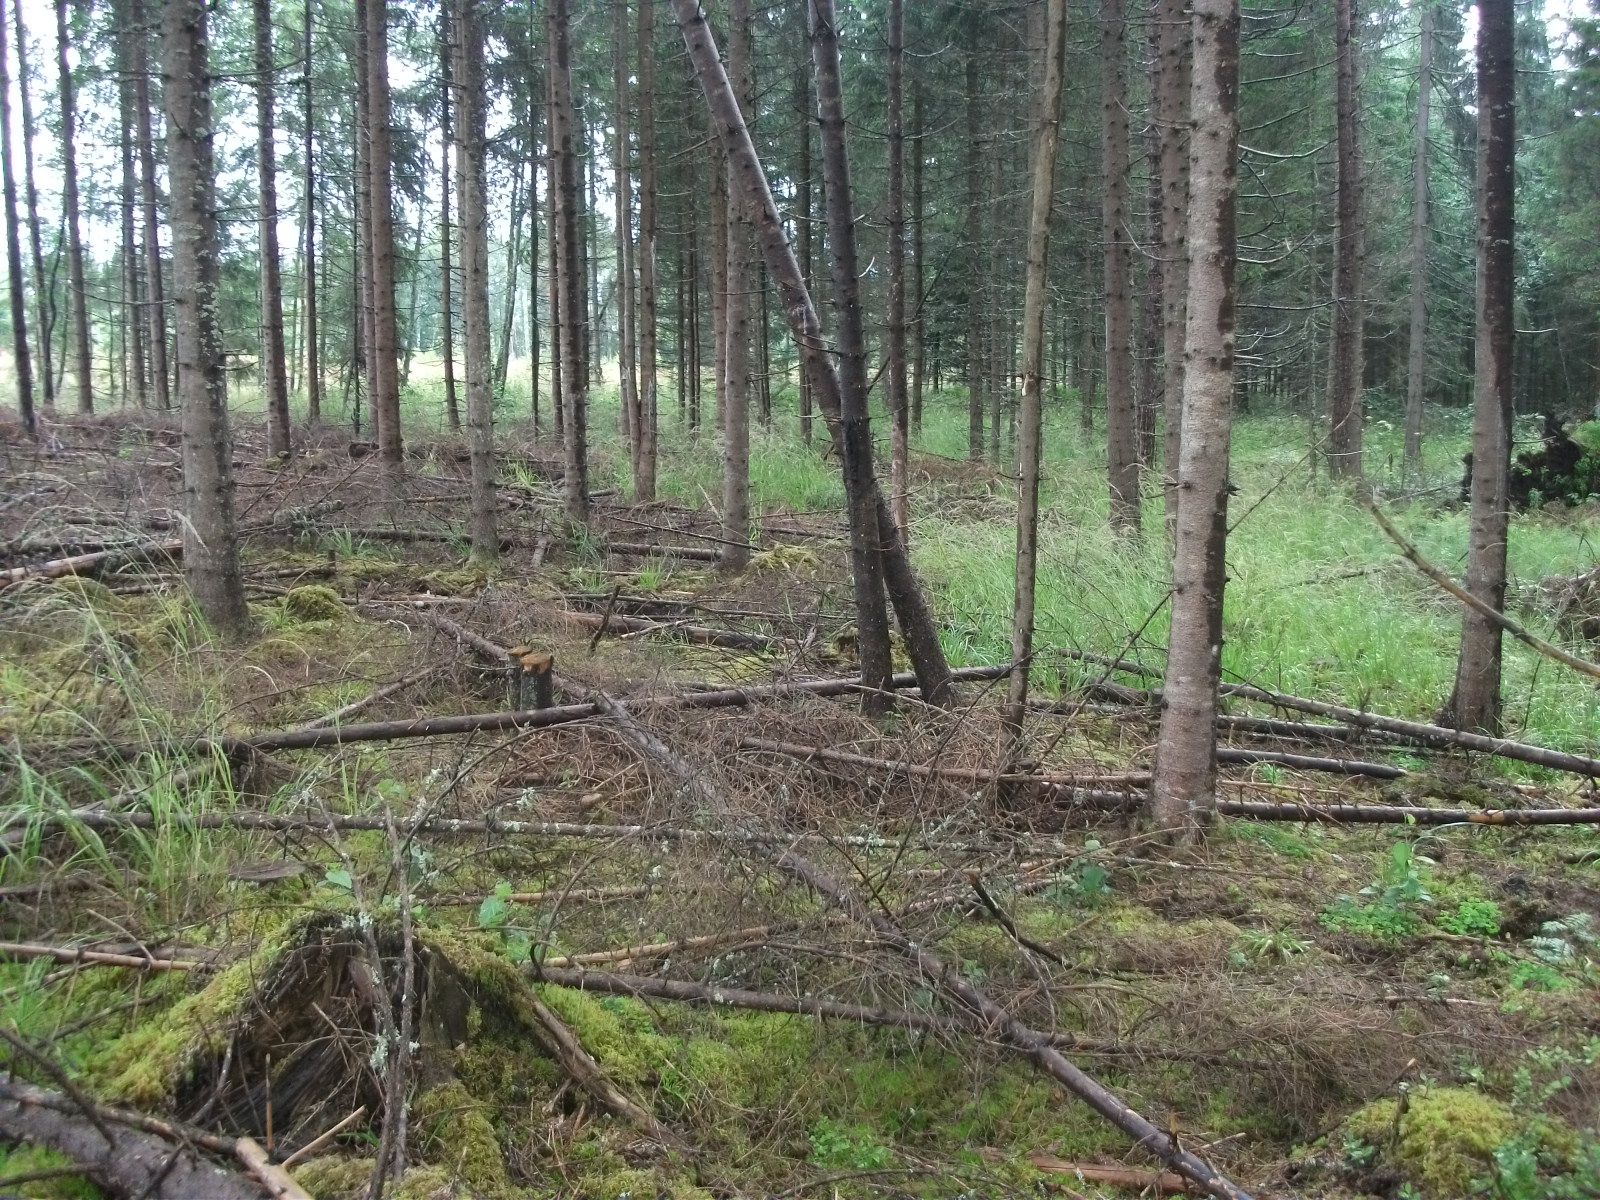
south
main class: Woodland
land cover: Spruce dominated coniferous woodland
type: hemiboreal forest and nemoral coniferous forest and mixed broadleaved-coniferous forest
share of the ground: 50 - 75 %
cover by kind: coniferous forest trees 60 %, herbaceous plants 15 %, lichens and mosses 15 %, unconsolidated bare surface 5 %
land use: Forestry
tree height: > 5 m
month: July
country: LV
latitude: 56.9729
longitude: 25.8711
